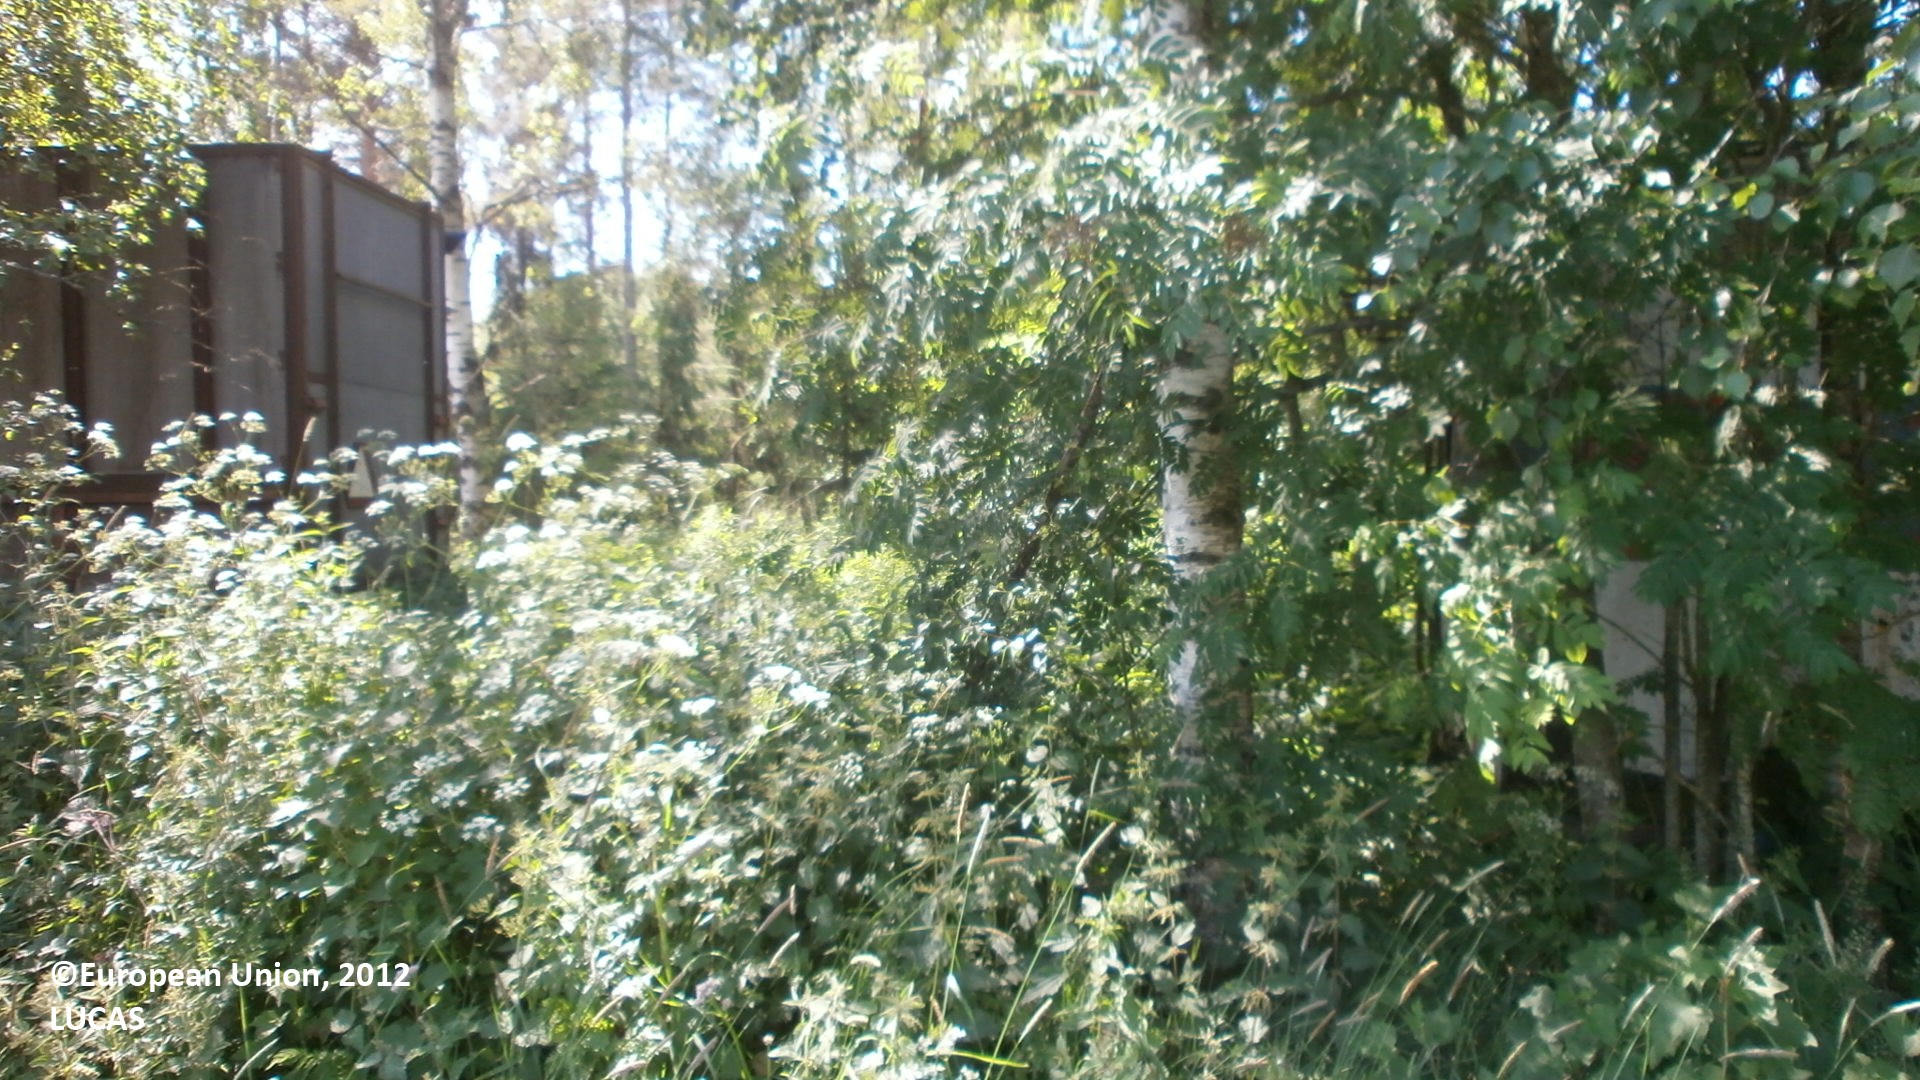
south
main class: Woodland
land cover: Spruce dominated mixed woodland
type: boreal forest
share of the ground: 50 - 75 %
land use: Forestry
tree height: > 5 m
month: July
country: FI
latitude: 63.9670
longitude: 24.8886
